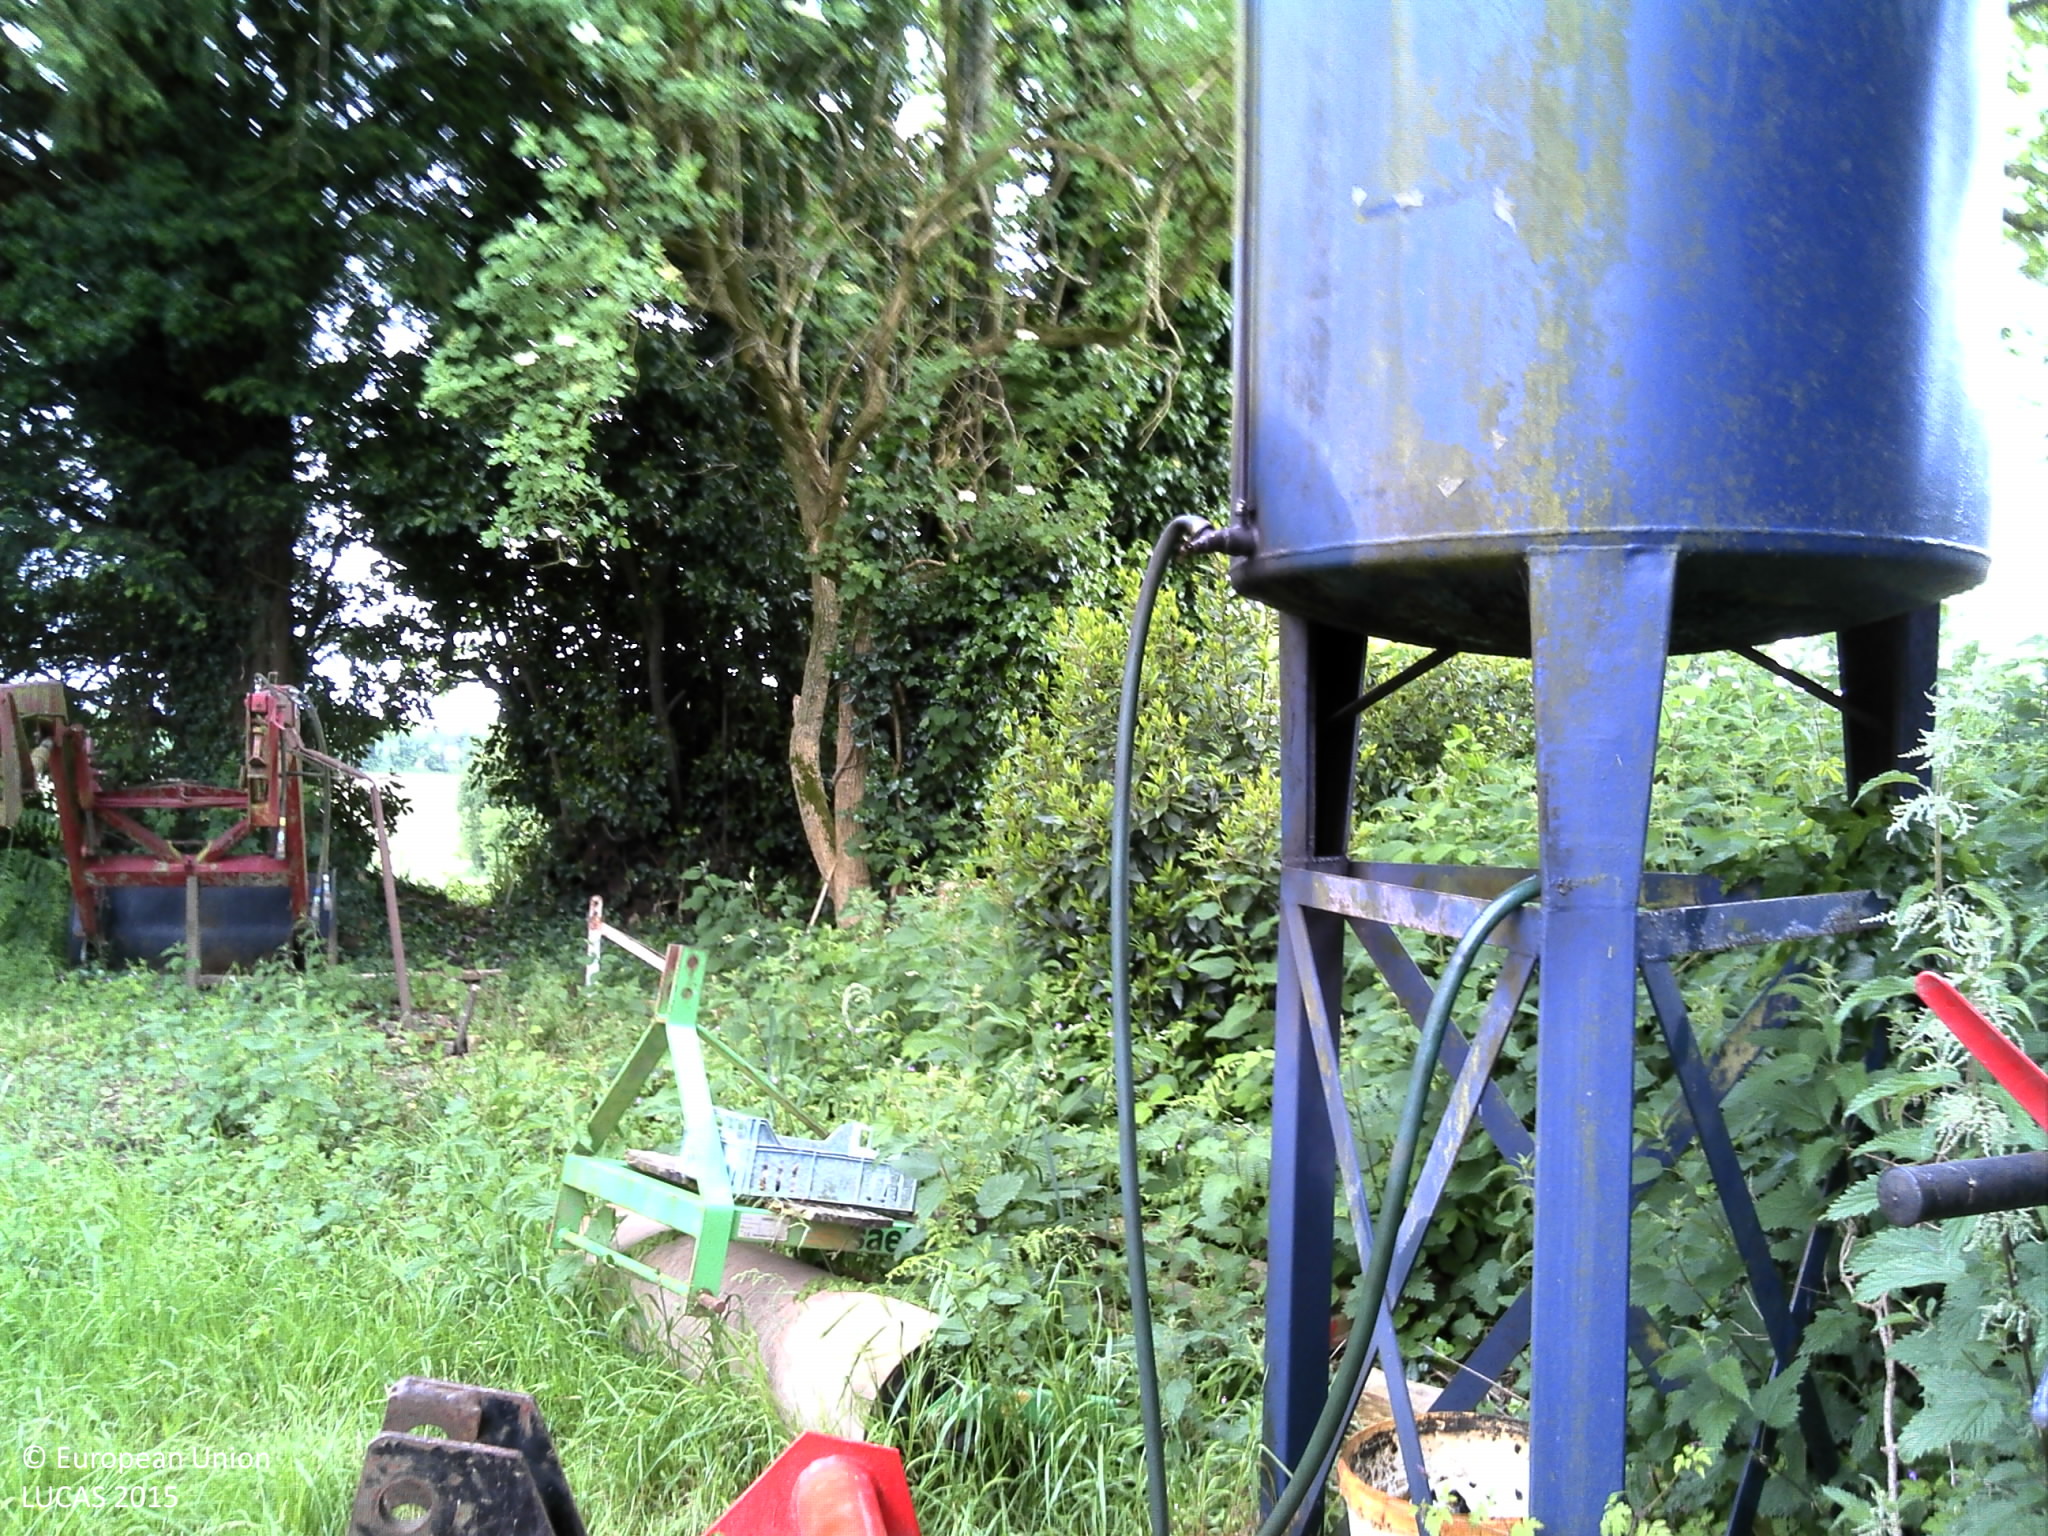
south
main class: Grassland
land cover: Grassland without tree/shrub cover
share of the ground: > 75 %
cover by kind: herbaceous plants 100 %
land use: Residential
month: June
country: FR
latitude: 47.9399
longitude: -3.6127
